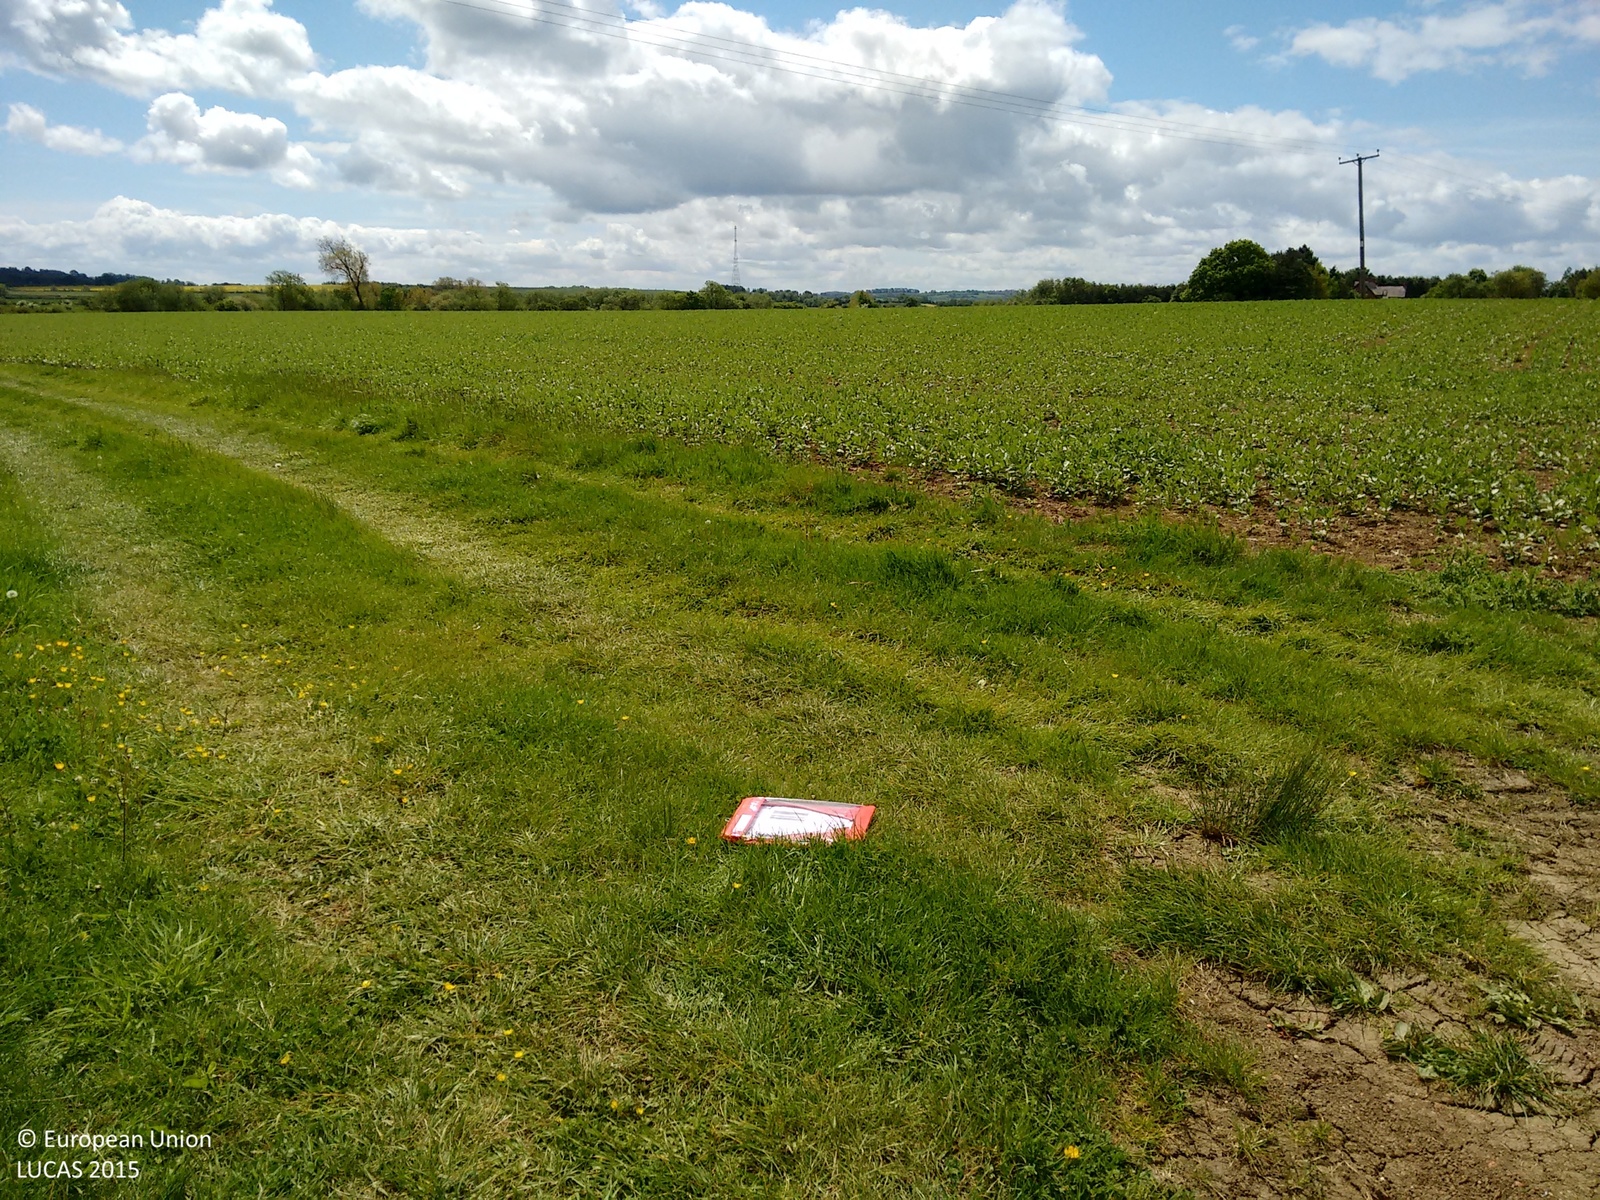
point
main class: Grassland
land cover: Grassland without tree/shrub cover
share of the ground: > 75 %
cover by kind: herbaceous plants 100 %
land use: Agriculture (excluding fallow land and kitchen gardens)
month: May
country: GB
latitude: 52.2113
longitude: -1.3620
